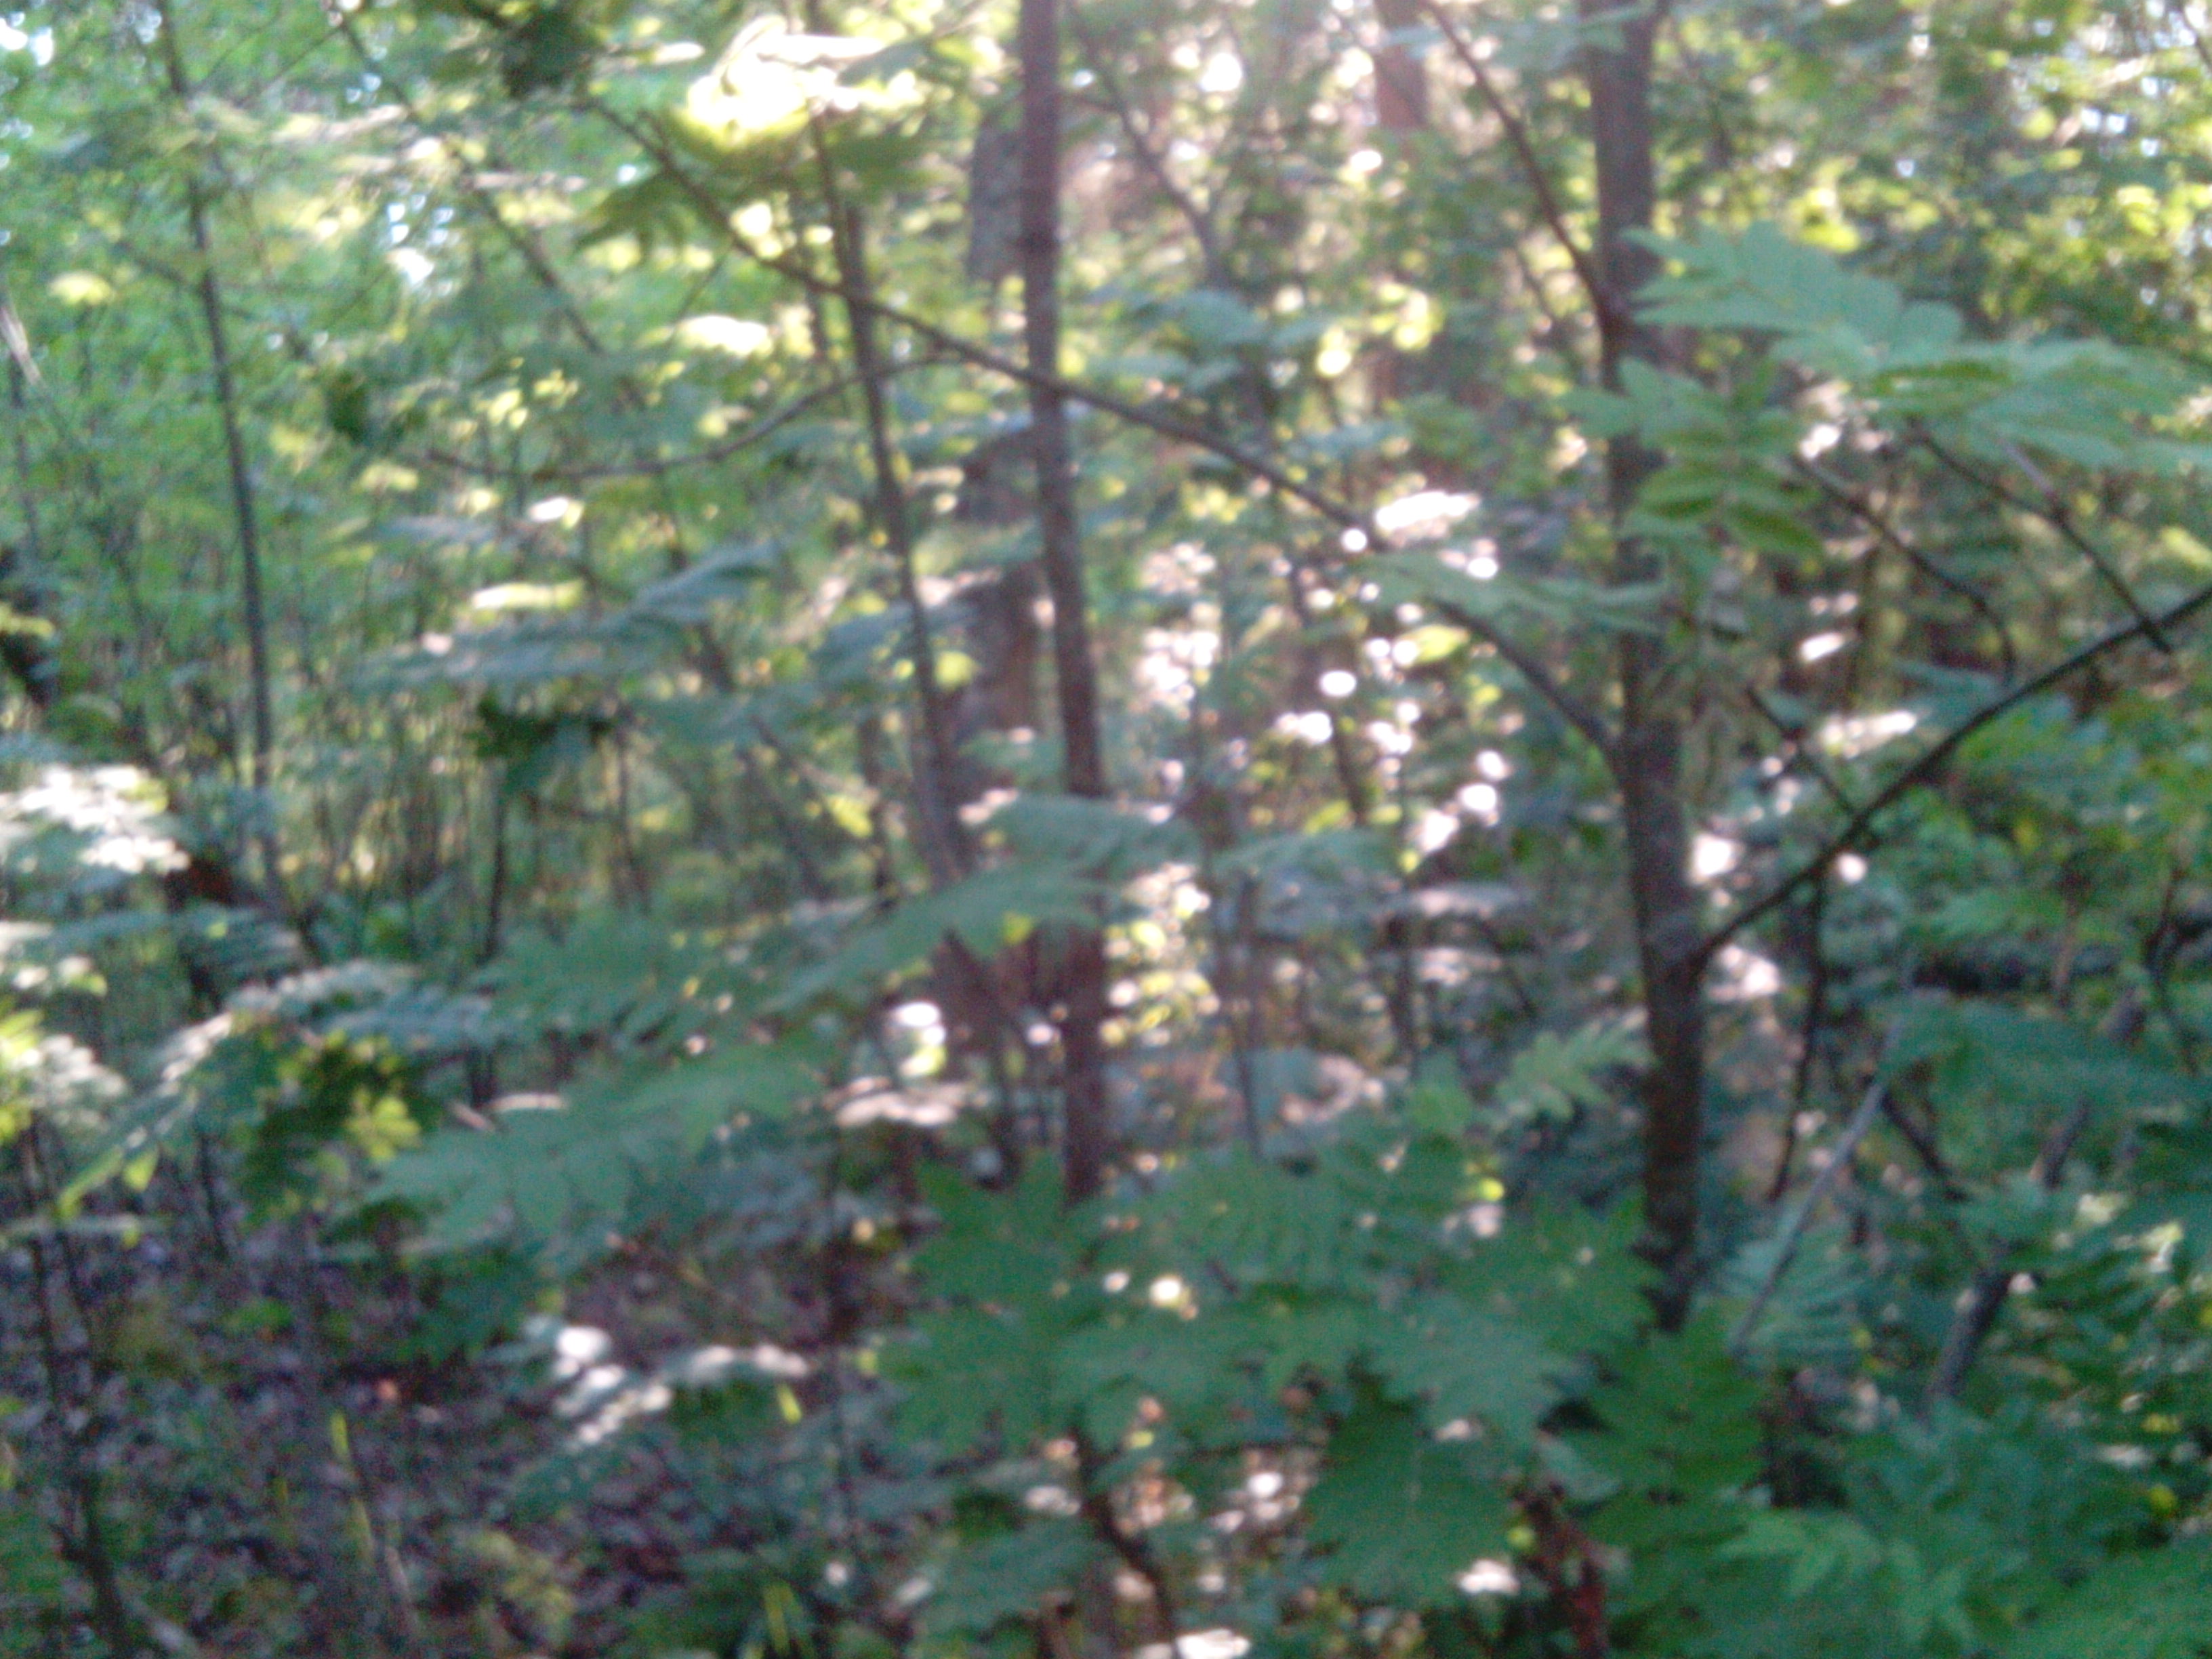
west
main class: Woodland
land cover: Spruce dominated mixed woodland
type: hemiboreal forest and nemoral coniferous forest and mixed broadleaved-coniferous forest
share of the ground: > 75 %
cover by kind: broadleaved forest trees 60 %, coniferous forest trees 30 %, shrubs 10 %
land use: Forestry
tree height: > 5 m
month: June
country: LV
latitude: 56.8031
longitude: 22.2190
